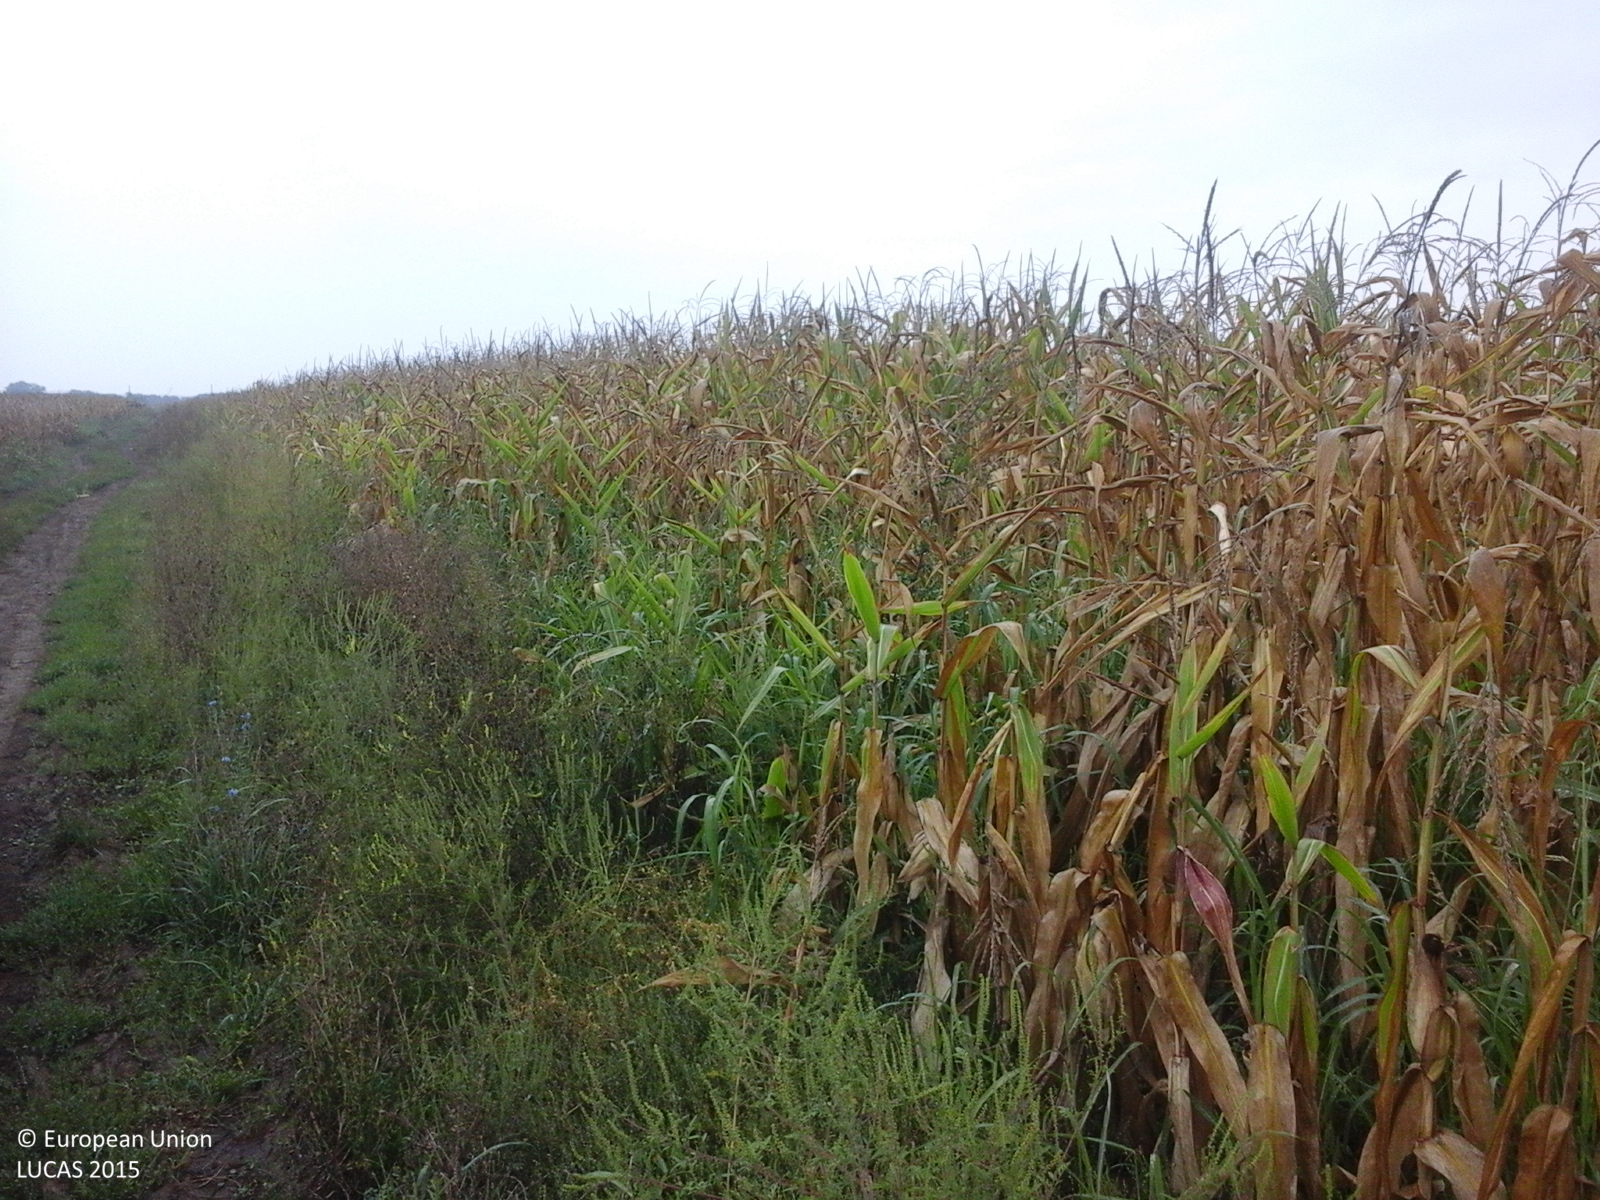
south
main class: Cropland
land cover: Maize
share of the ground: > 75 %
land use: Agriculture (excluding fallow land and kitchen gardens)
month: September
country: RO
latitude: 47.4445
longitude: 22.1053
